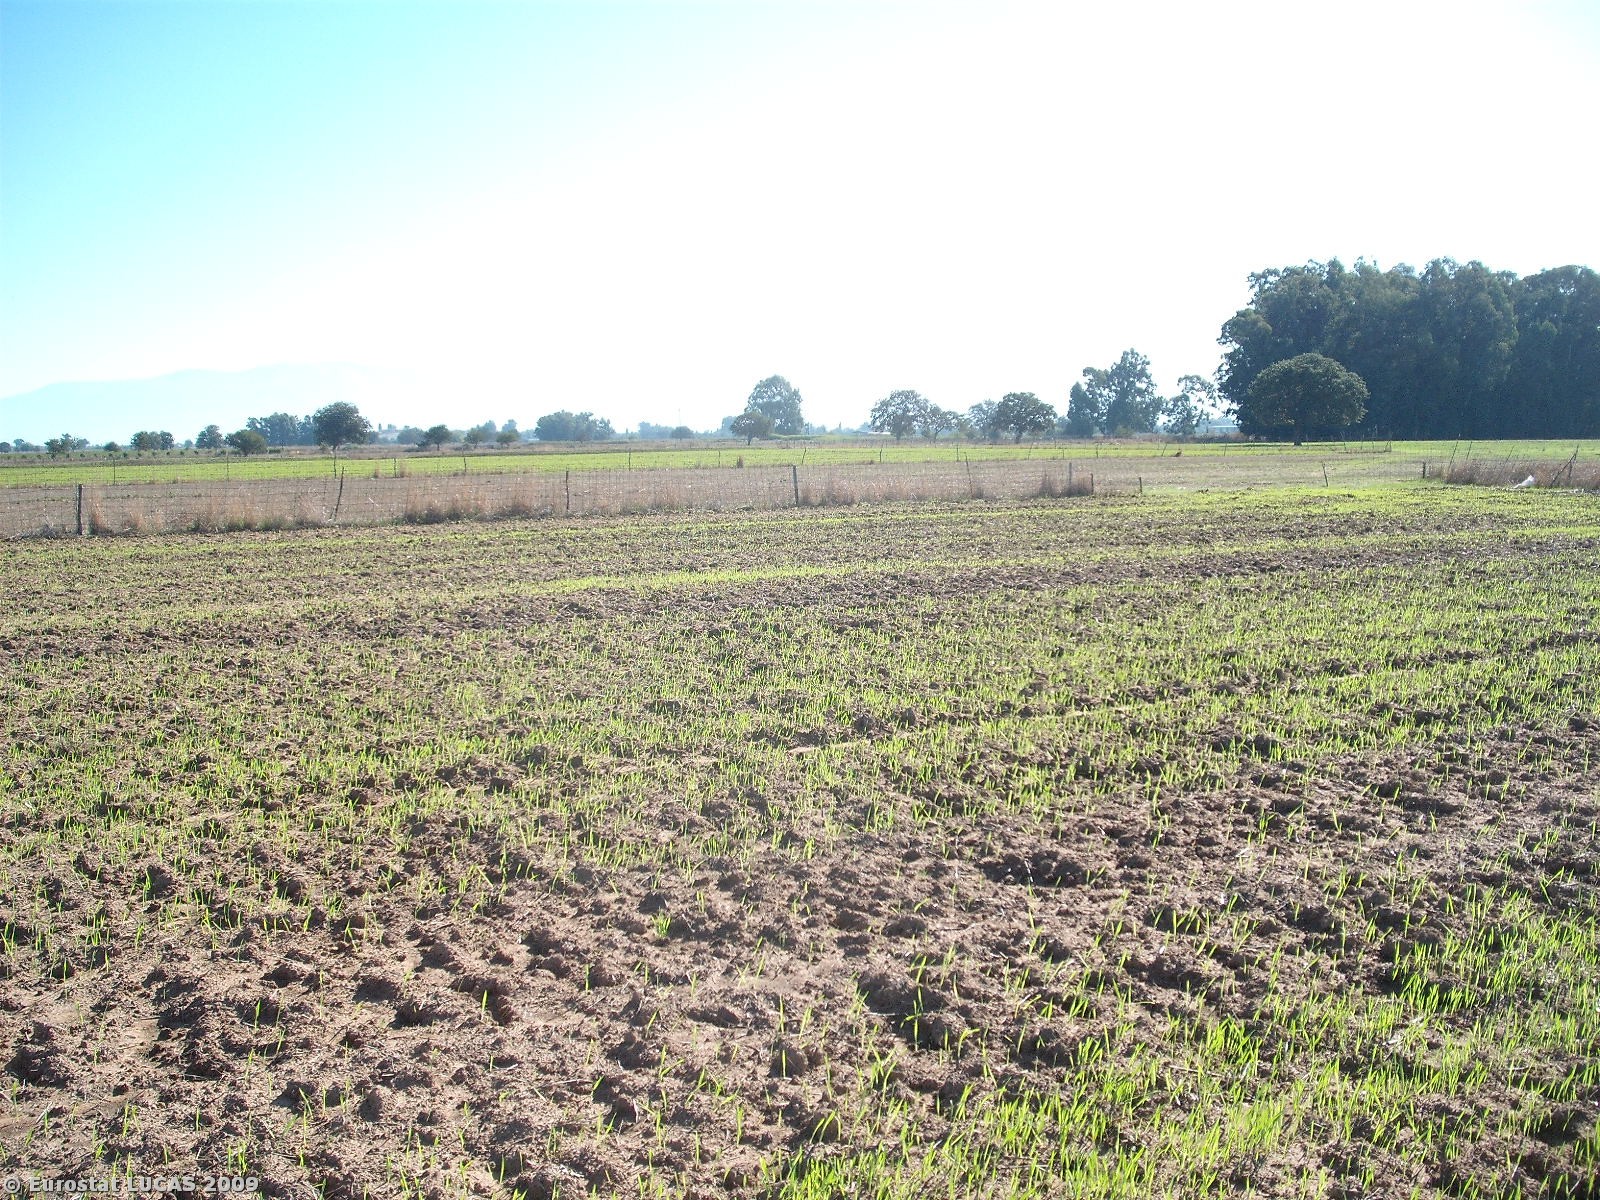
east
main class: Cropland
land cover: Mixed cereals for fodder
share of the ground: < 10 %
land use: Agriculture (excluding fallow land and kitchen gardens)
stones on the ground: < 10 %
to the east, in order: Mixed cereals for fodder; Fences; Oats; Fences; Mixed cereals for fodder; Fences; Ditches and canals; Fences; Mixed cereals for fodder
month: October
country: GR
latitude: 38.1505
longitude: 21.4559
